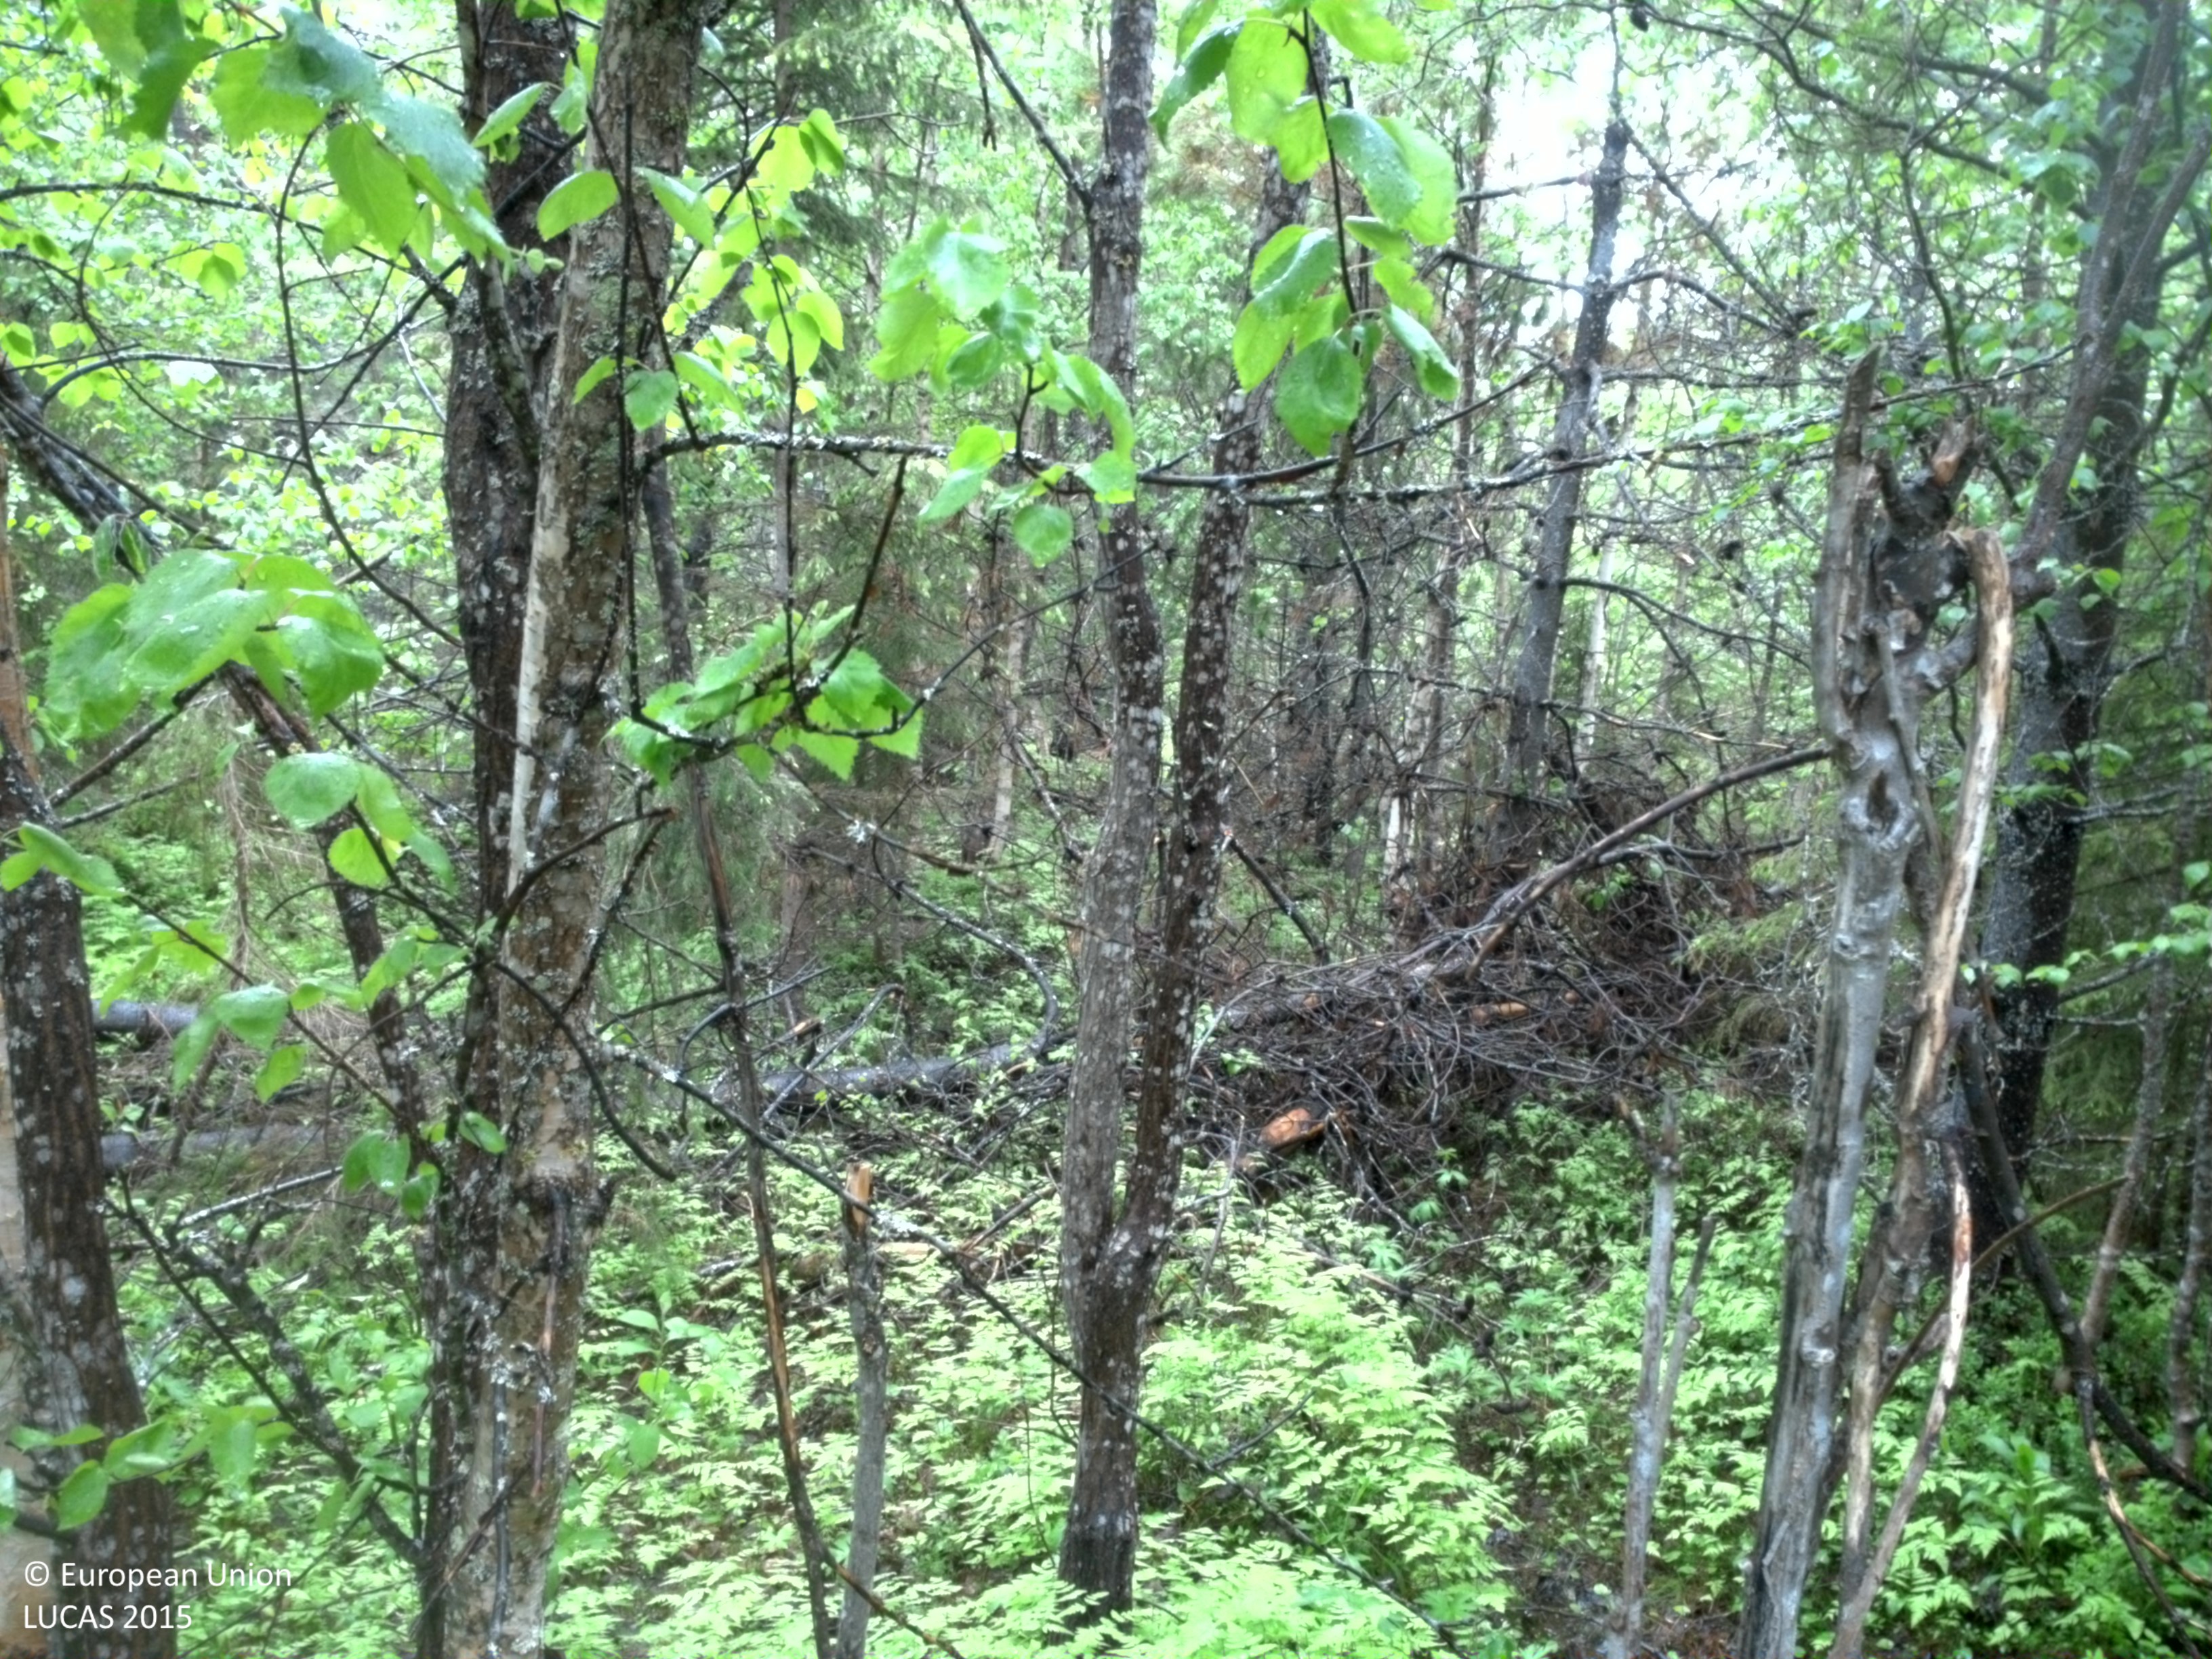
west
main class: Woodland
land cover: Pine dominated mixed woodland
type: exotic forest
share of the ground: > 75 %
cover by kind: coniferous forest trees 40 %, broadleaved forest trees 40 %, shrubs 10 %, herbaceous plants 10 %
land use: Forestry
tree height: > 5 m
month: June
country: SE
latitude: 66.5776
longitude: 22.8016
